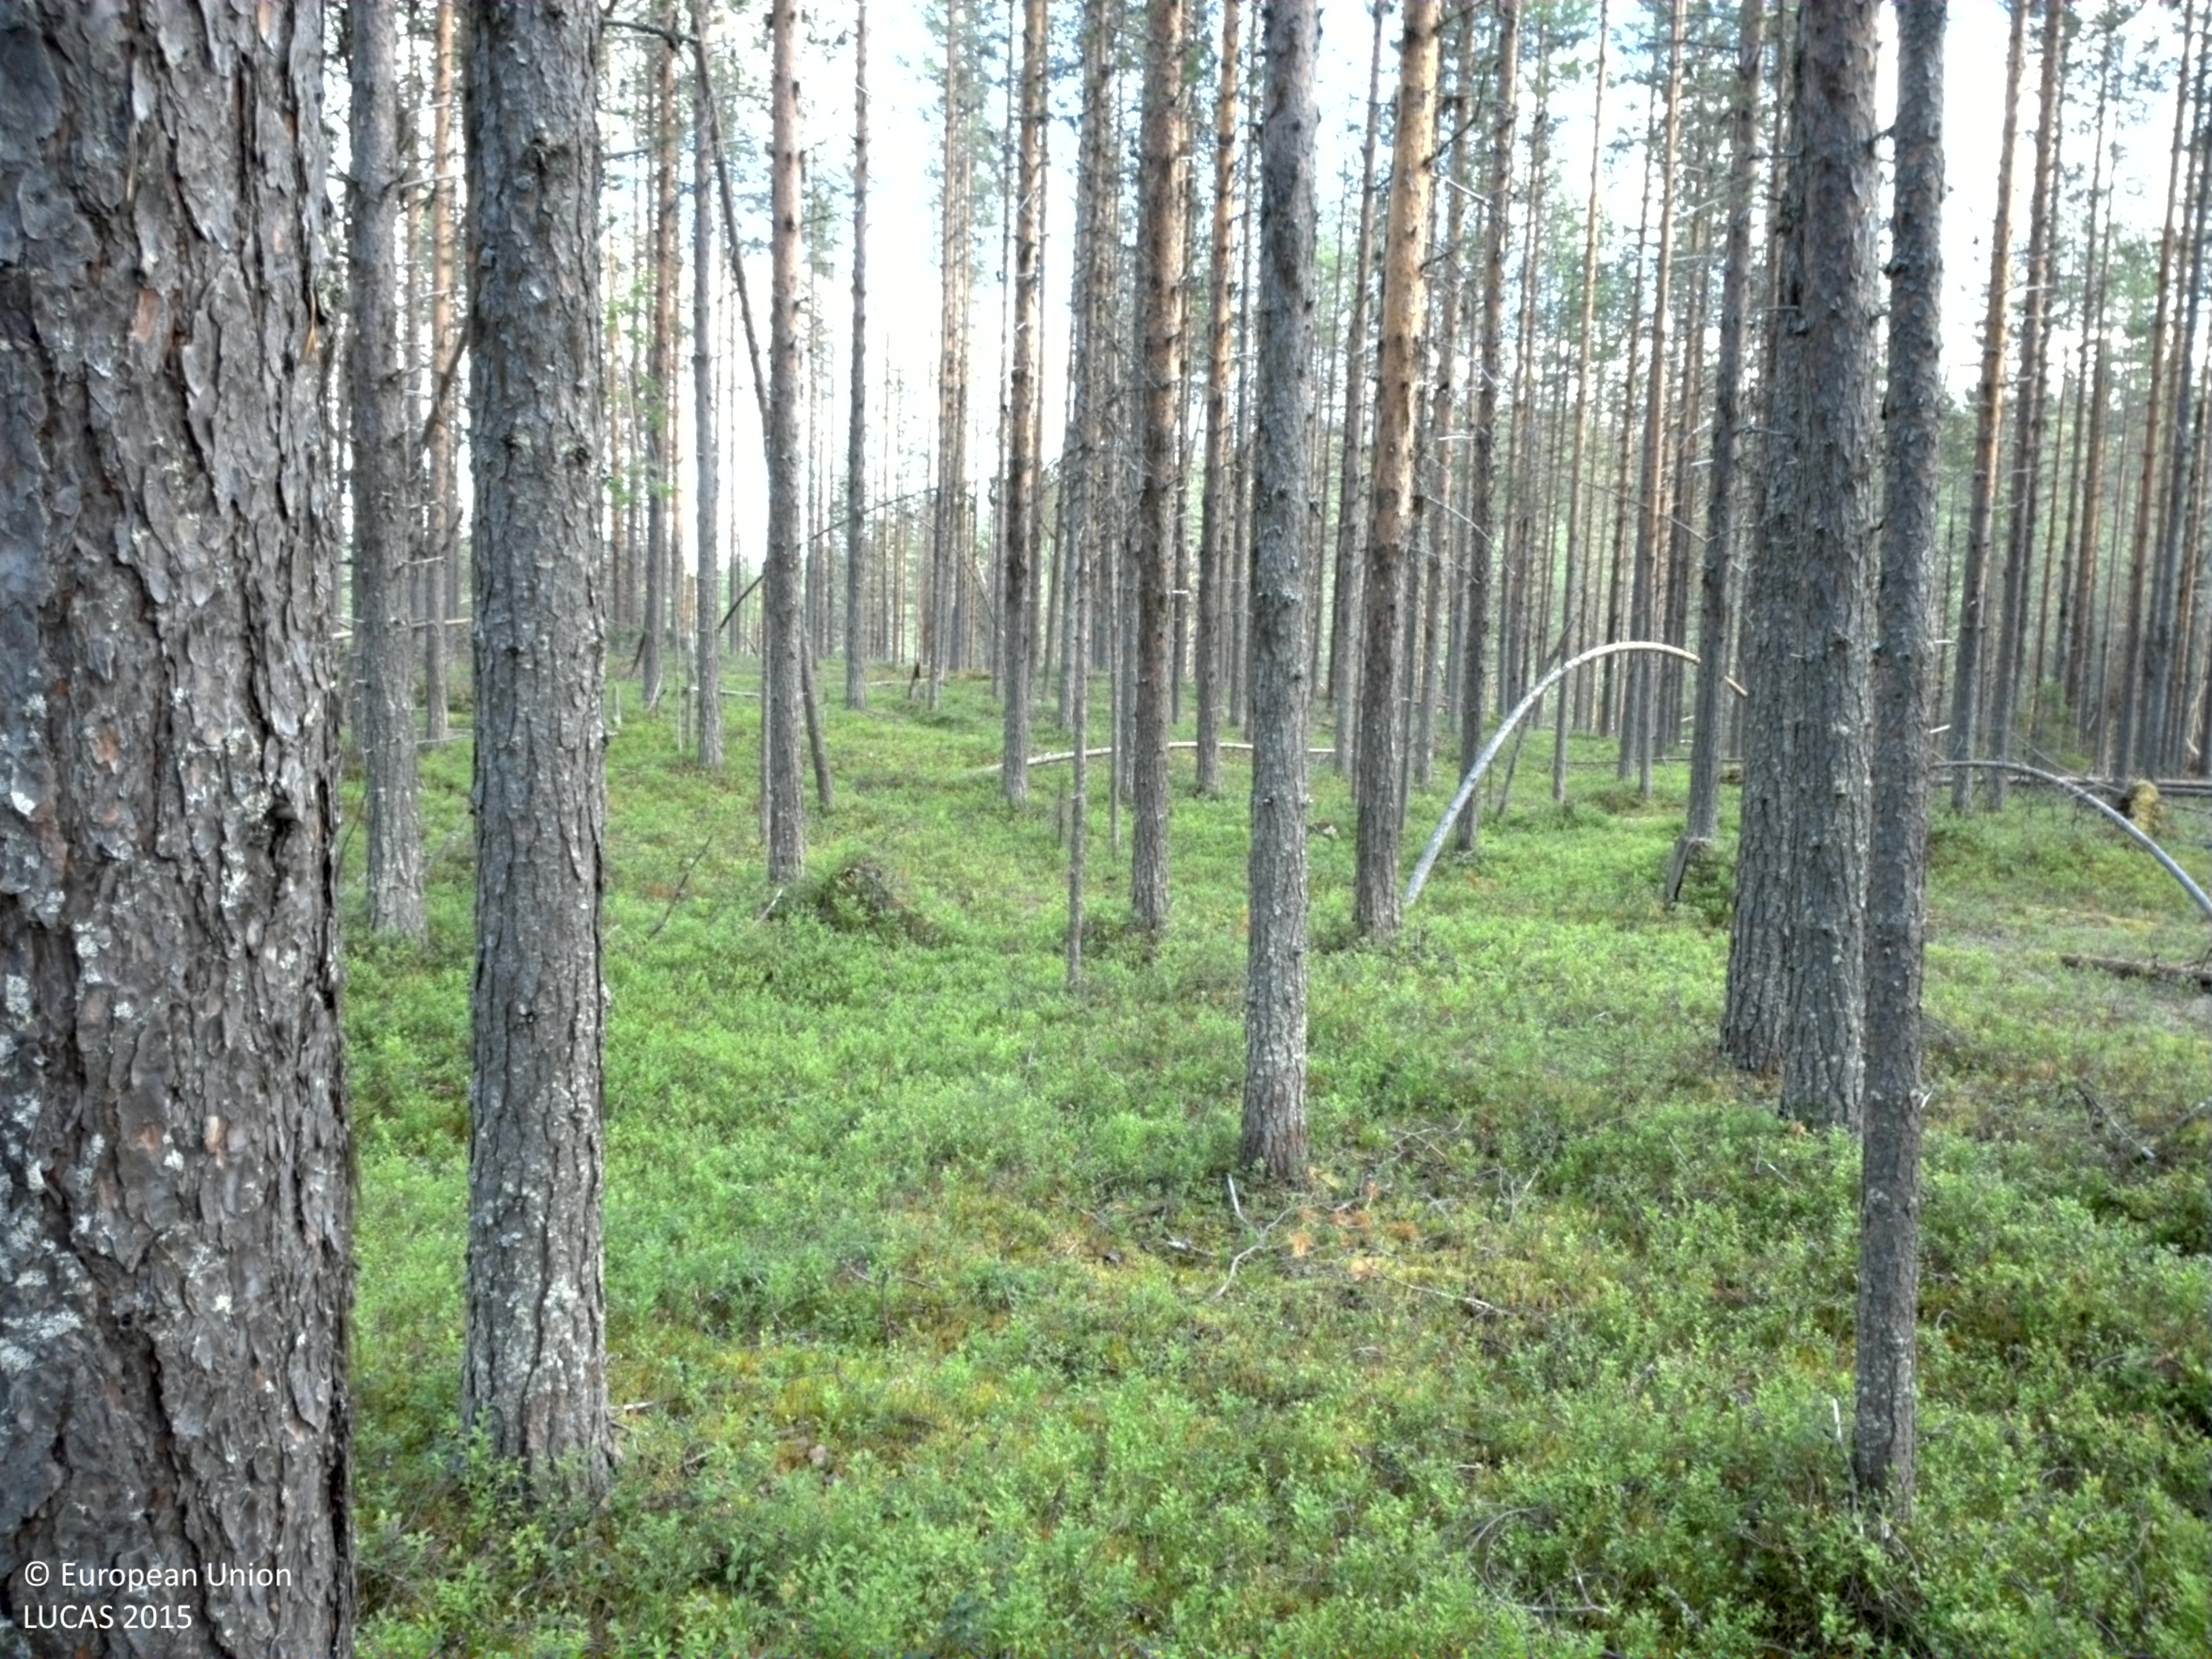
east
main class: Woodland
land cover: Pine dominated coniferous woodland
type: boreal forest
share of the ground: 25 - 50 %
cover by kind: shrubs 65 %, coniferous forest trees 35 %
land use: Forestry
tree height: > 5 m
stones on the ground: < 10 %
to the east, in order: Pine dominated coniferous woodland; Shrubland with sparse tree cover; Broadleaved woodland; Pine dominated coniferous woodland
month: August
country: SE
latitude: 66.4988
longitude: 20.7671
